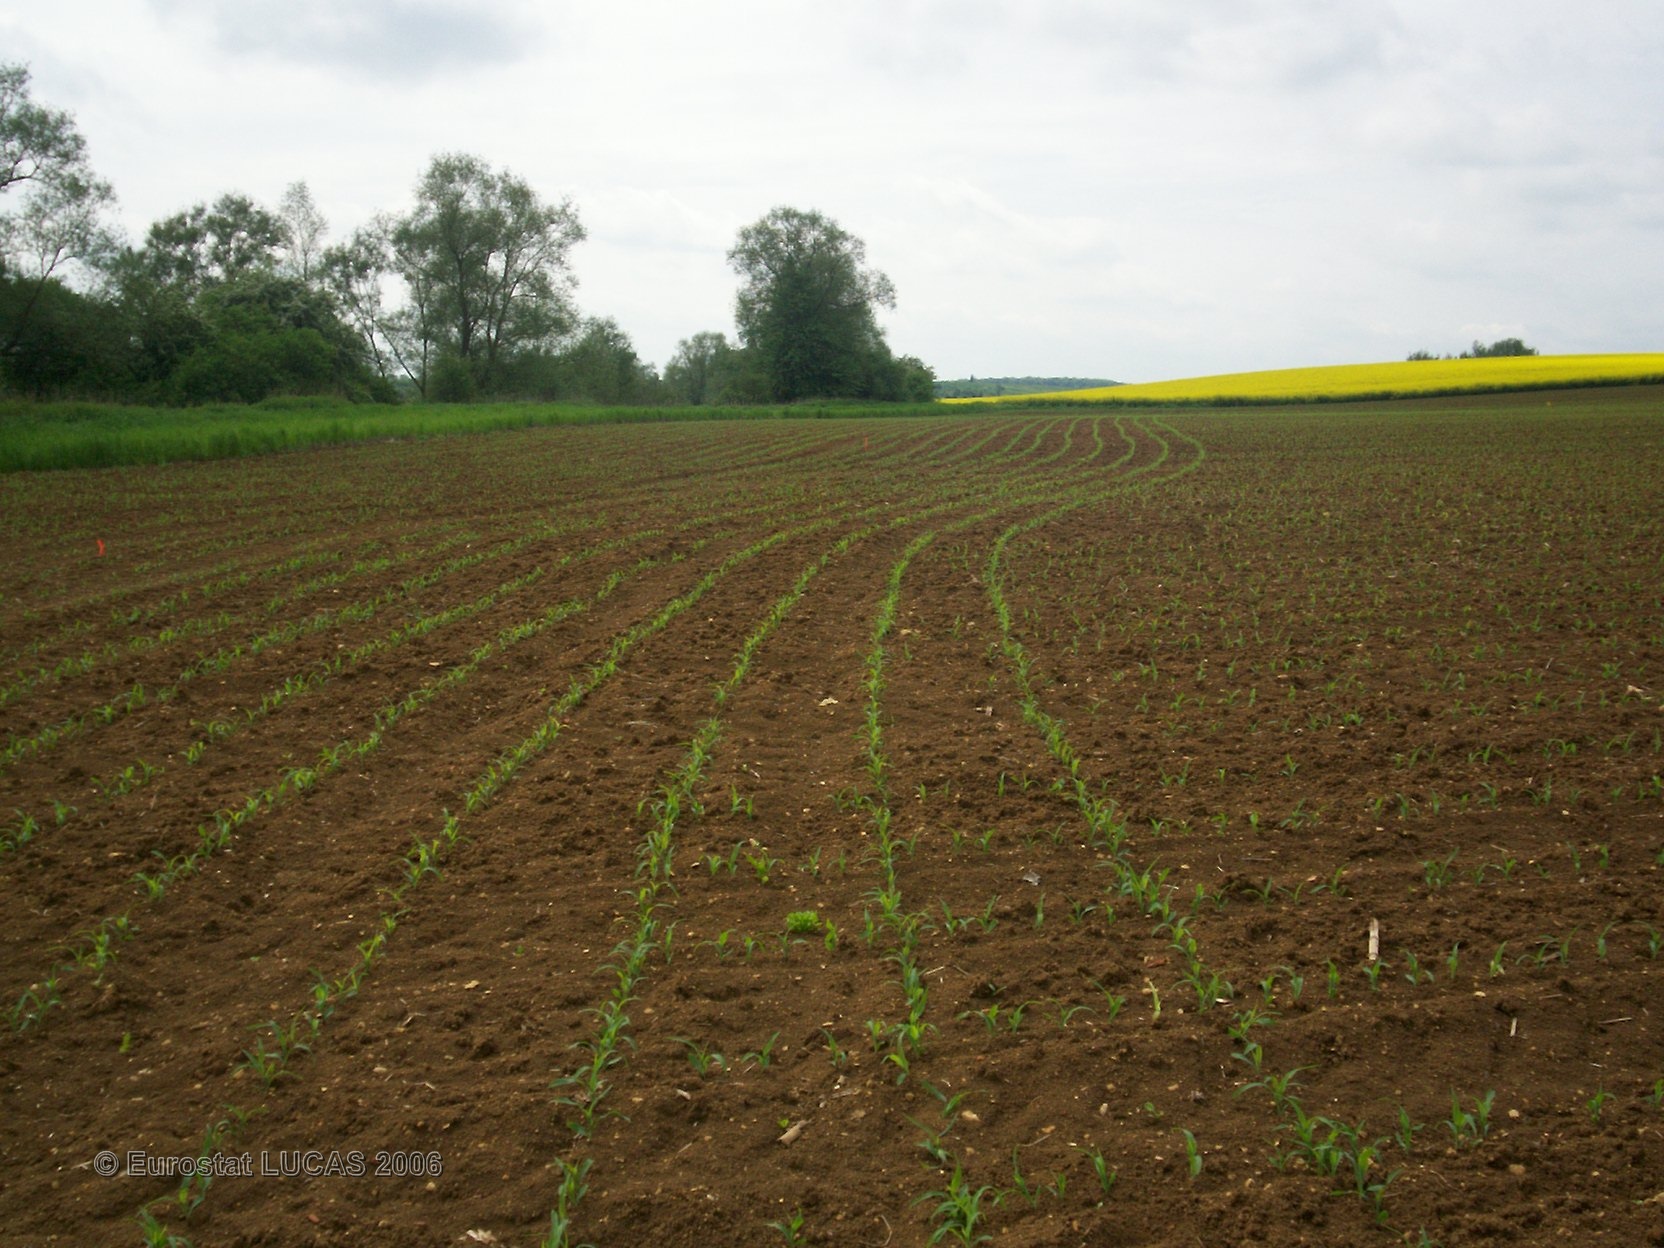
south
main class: Cropland
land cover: Maize
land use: Agriculture (excluding fallow land and kitchen gardens)
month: May
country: FR
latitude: 49.1371
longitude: 5.8736
